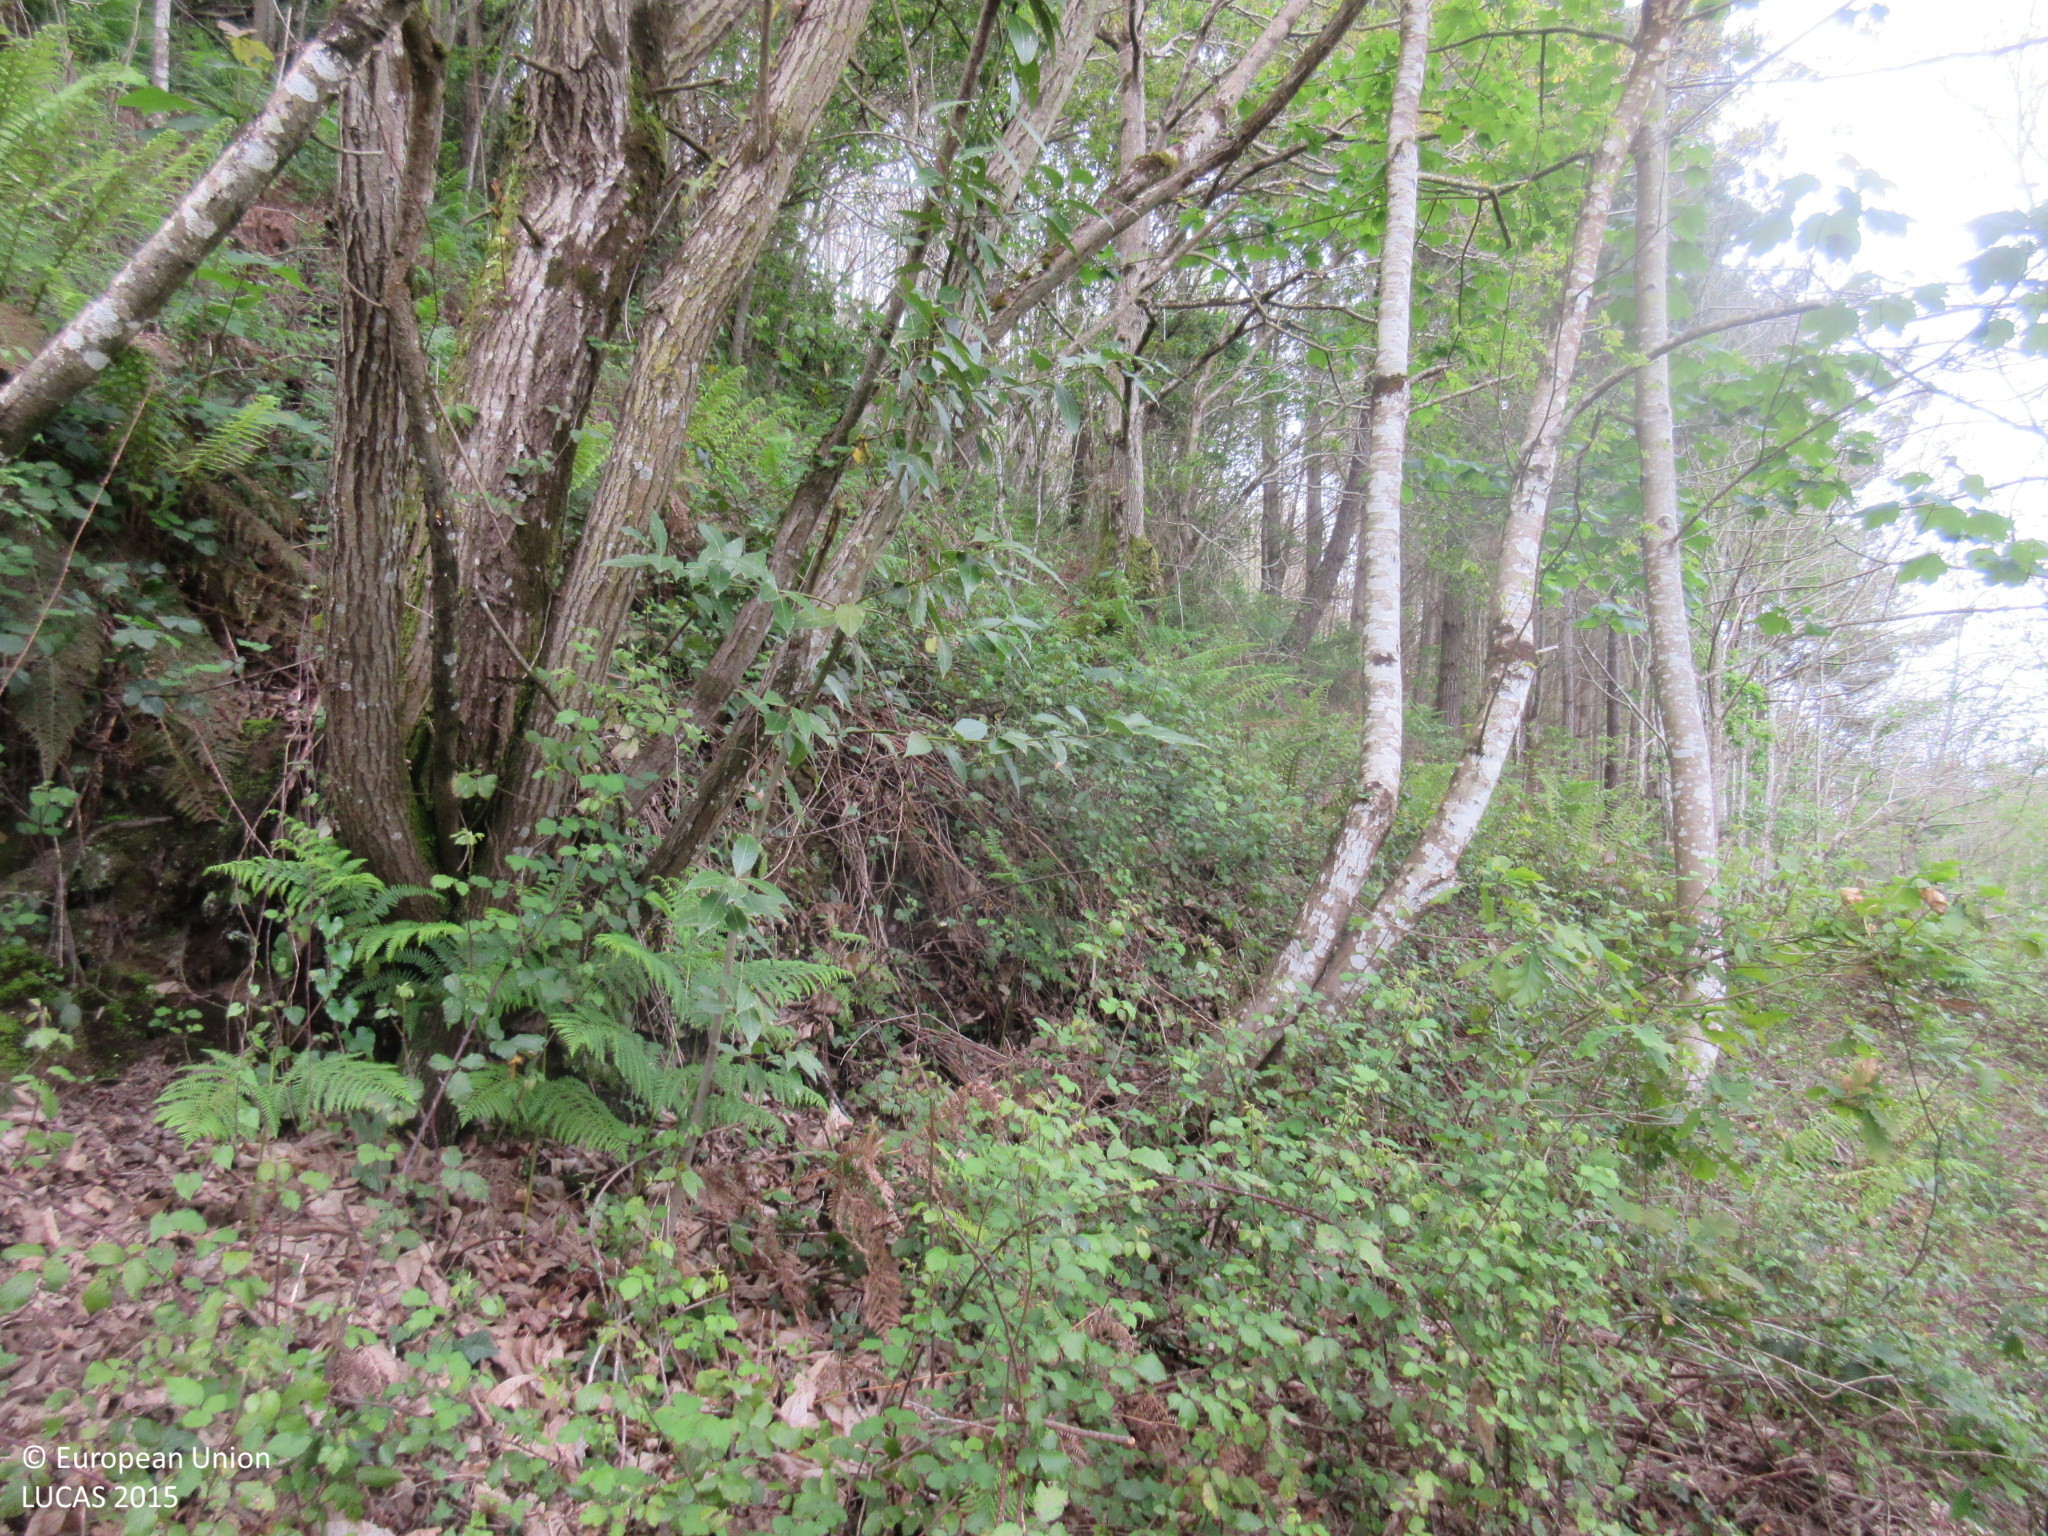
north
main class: Woodland
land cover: Broadleaved woodland
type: acidophilous oak and oak-birch forest
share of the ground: > 75 %
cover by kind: broadleaved forest trees 100 %
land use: Forestry
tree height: > 5 m
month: April
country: ES
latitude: 43.5059
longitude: -6.4423
